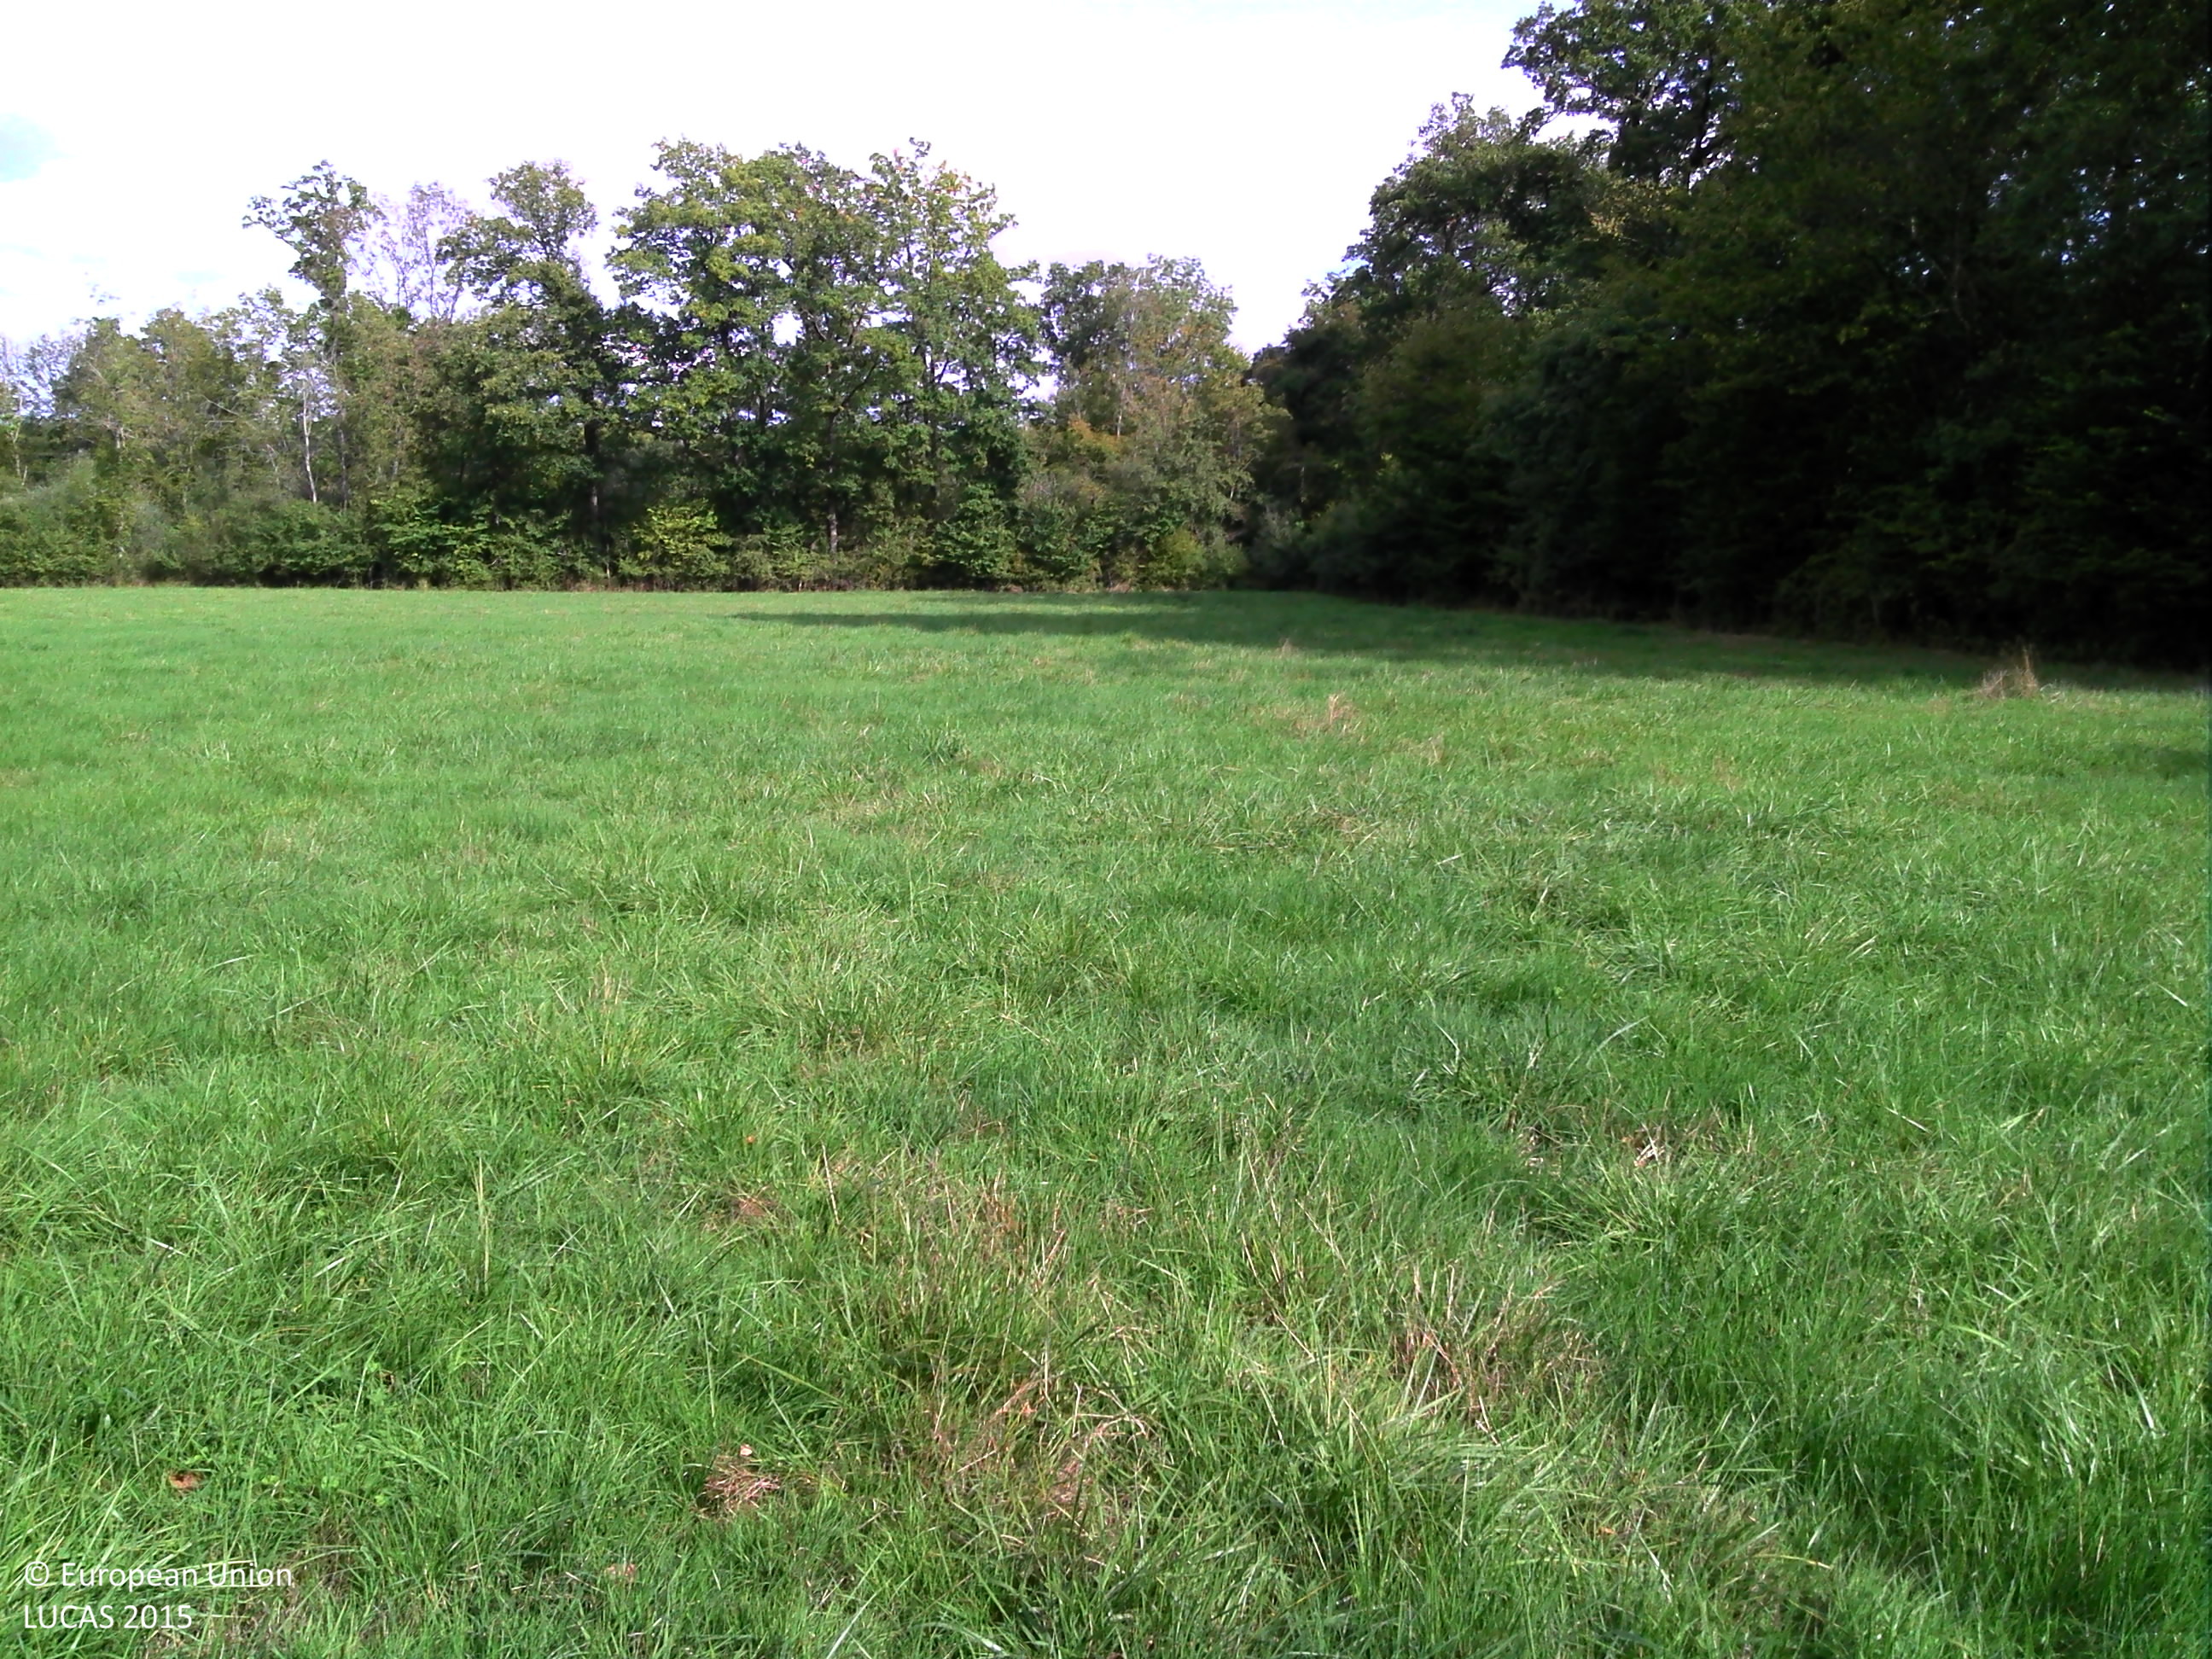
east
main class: Grassland
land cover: Grassland without tree/shrub cover
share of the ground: > 75 %
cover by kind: herbaceous plants 100 %
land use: Agriculture (excluding fallow land and kitchen gardens)
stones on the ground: < 10 %
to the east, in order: Grassland without tree/shrub cover; Spontaneously vegetated surfaces; Broadleaved woodland; Fences; Grassland without tree/shrub cover
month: September
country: FR
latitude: 48.5072
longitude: 4.6239
